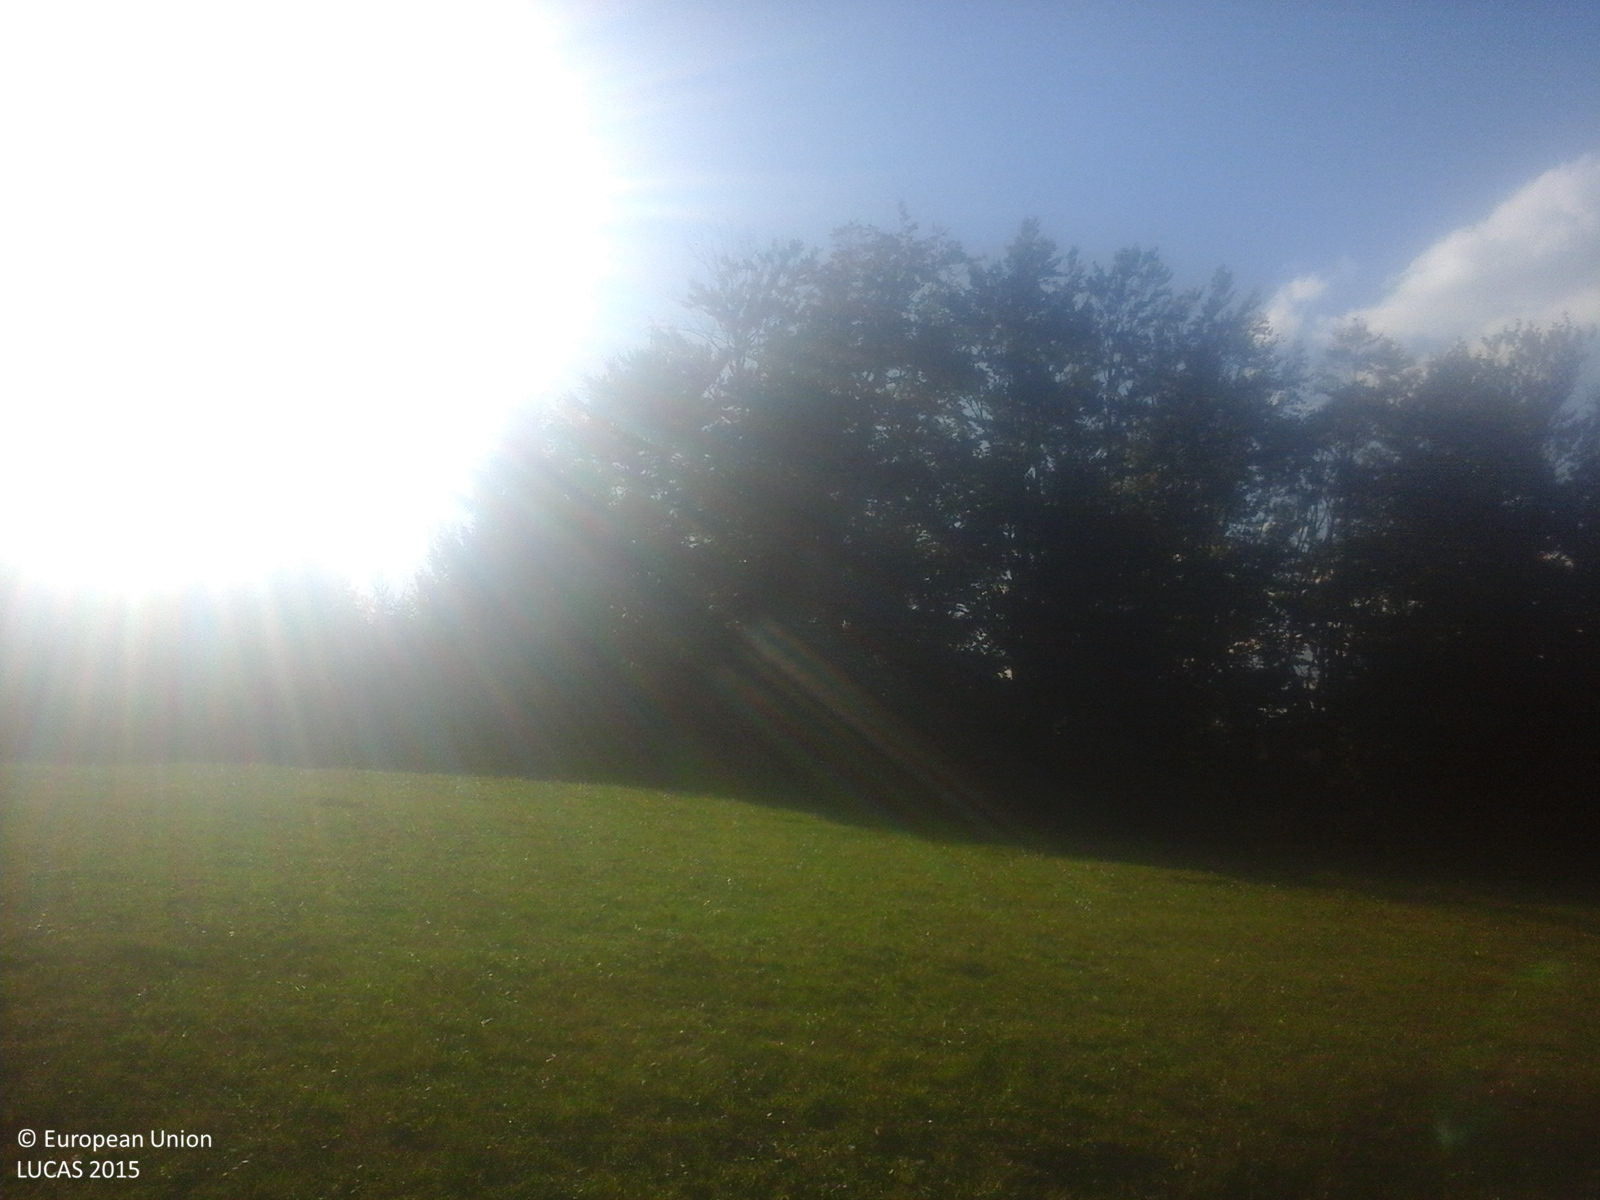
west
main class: Grassland
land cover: Grassland without tree/shrub cover
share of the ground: > 75 %
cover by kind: herbaceous plants 100 %
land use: Agriculture (excluding fallow land and kitchen gardens)
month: October
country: RO
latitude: 46.2355
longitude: 23.0915
